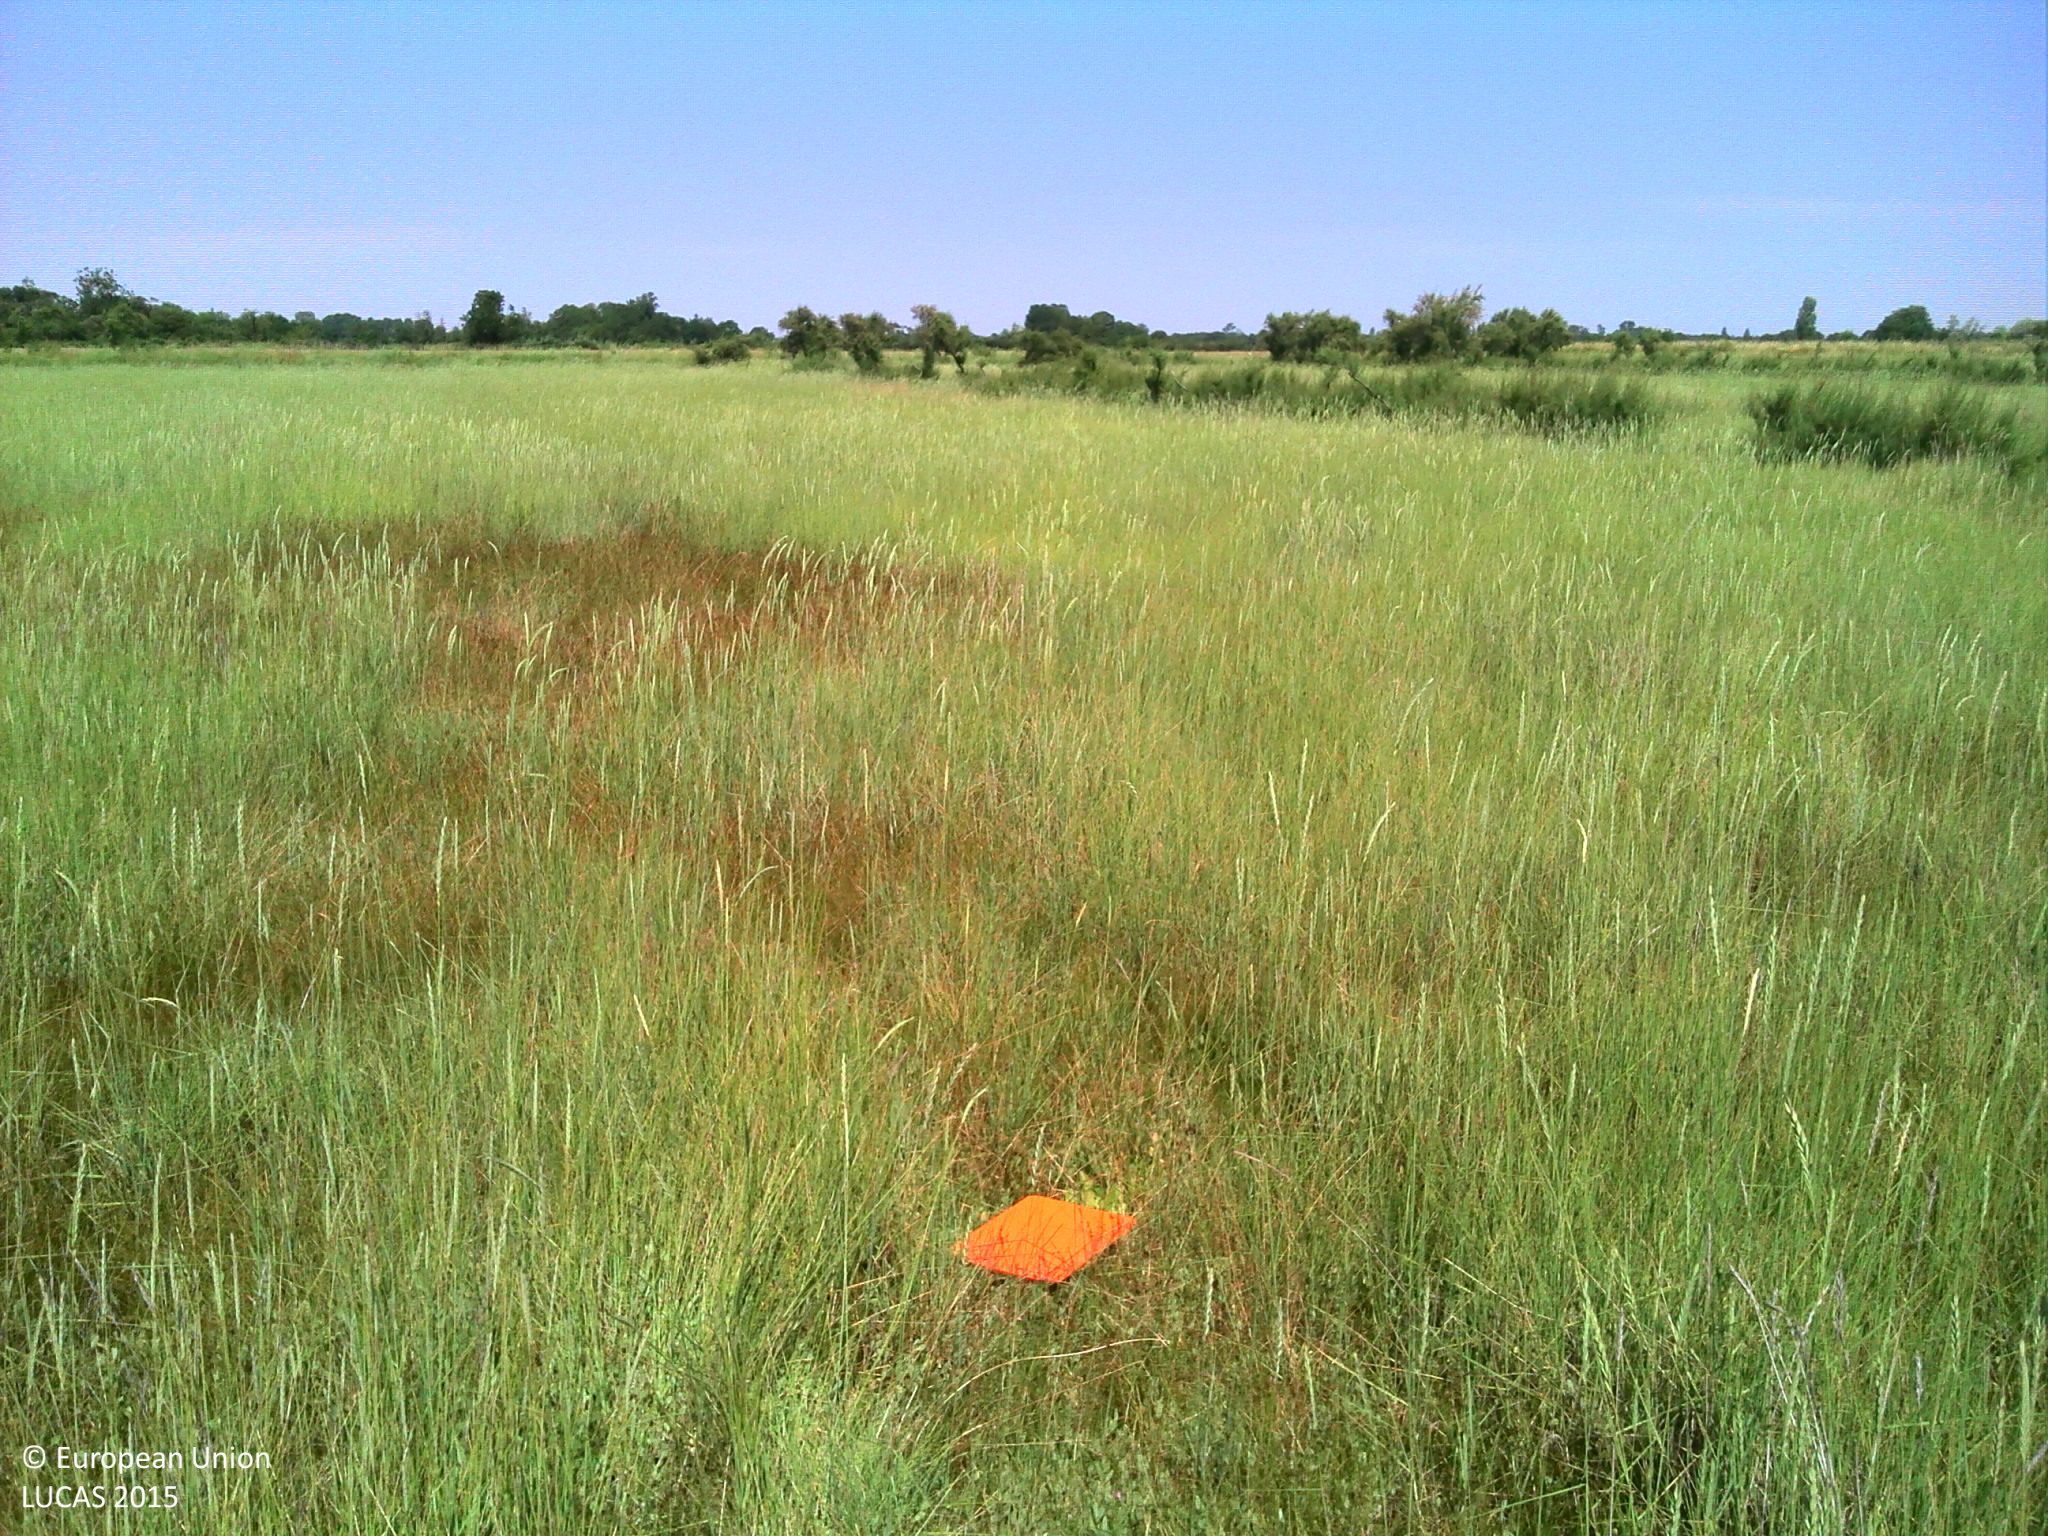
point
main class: Grassland
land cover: Grassland without tree/shrub cover
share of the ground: > 75 %
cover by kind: herbaceous plants 100 %
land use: Agriculture (excluding fallow land and kitchen gardens)
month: June
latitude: 45.6958
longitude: -0.9560
